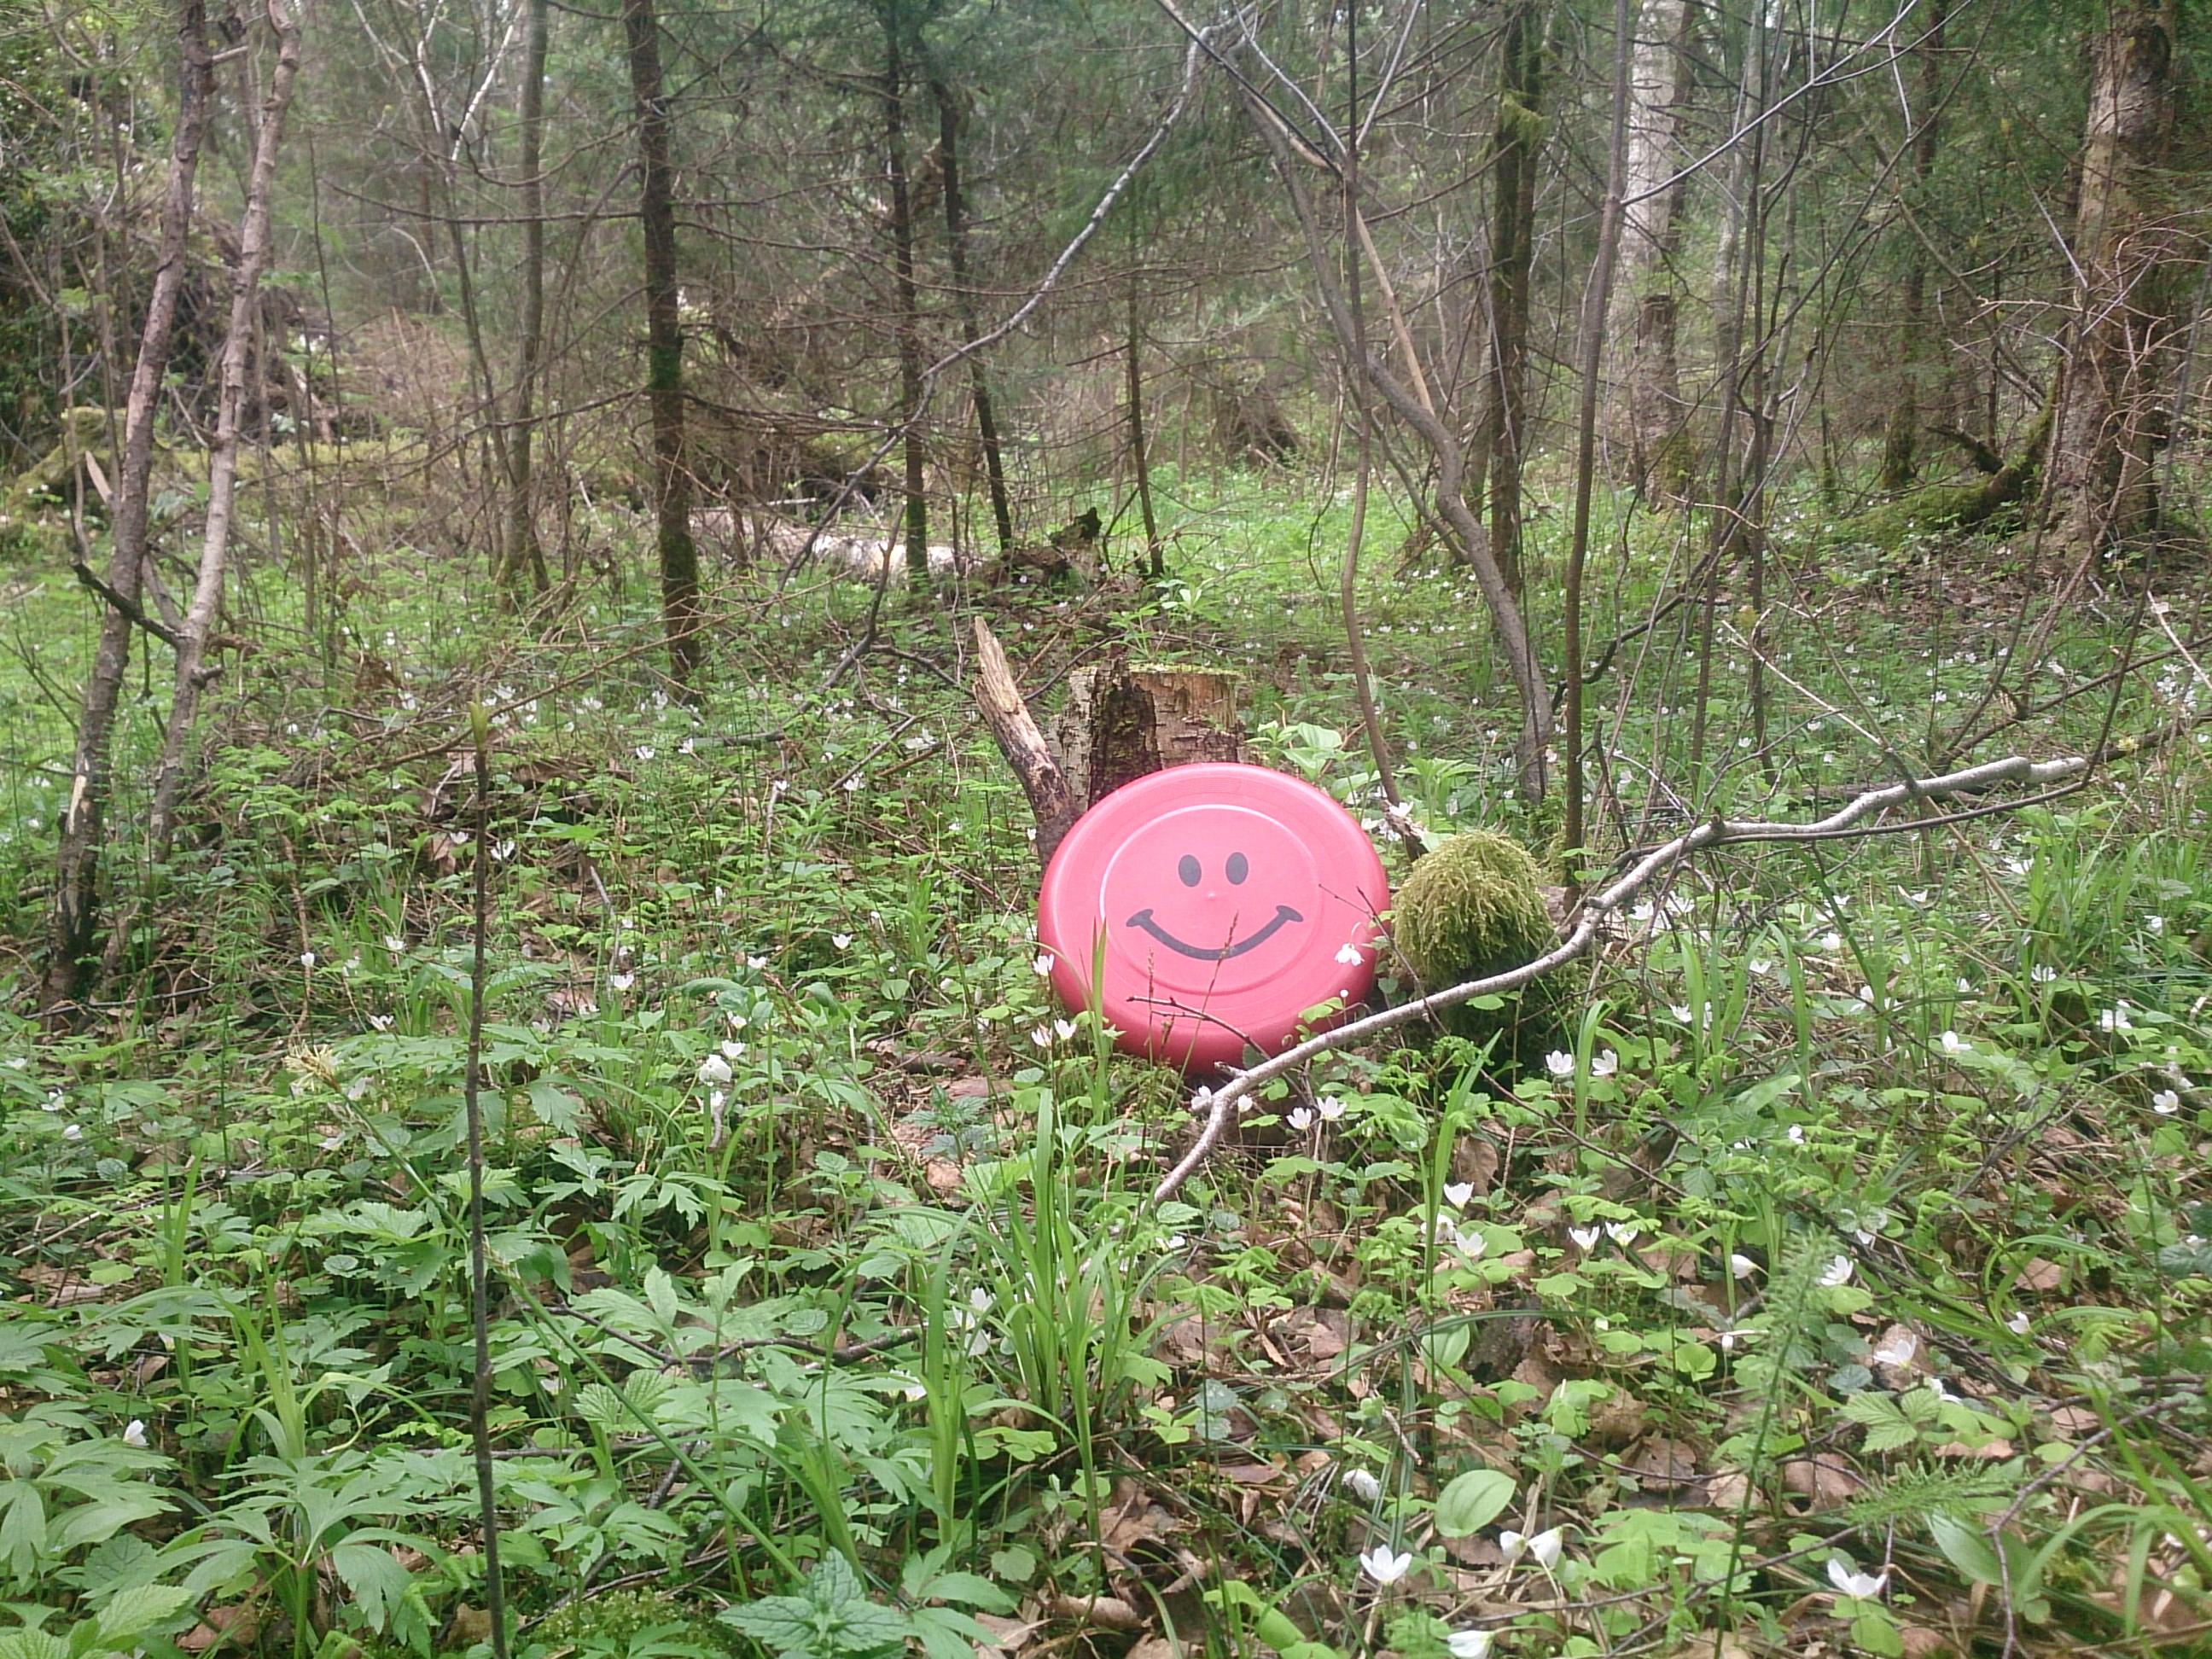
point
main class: Woodland
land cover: Spruce dominated mixed woodland
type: hemiboreal forest and nemoral coniferous forest and mixed broadleaved-coniferous forest
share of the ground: > 75 %
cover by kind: coniferous forest trees 55 %, broadleaved forest trees 40 %, herbaceous plants 5 %
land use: Forestry
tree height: > 5 m
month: May
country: LV
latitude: 56.6900
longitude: 24.0449
